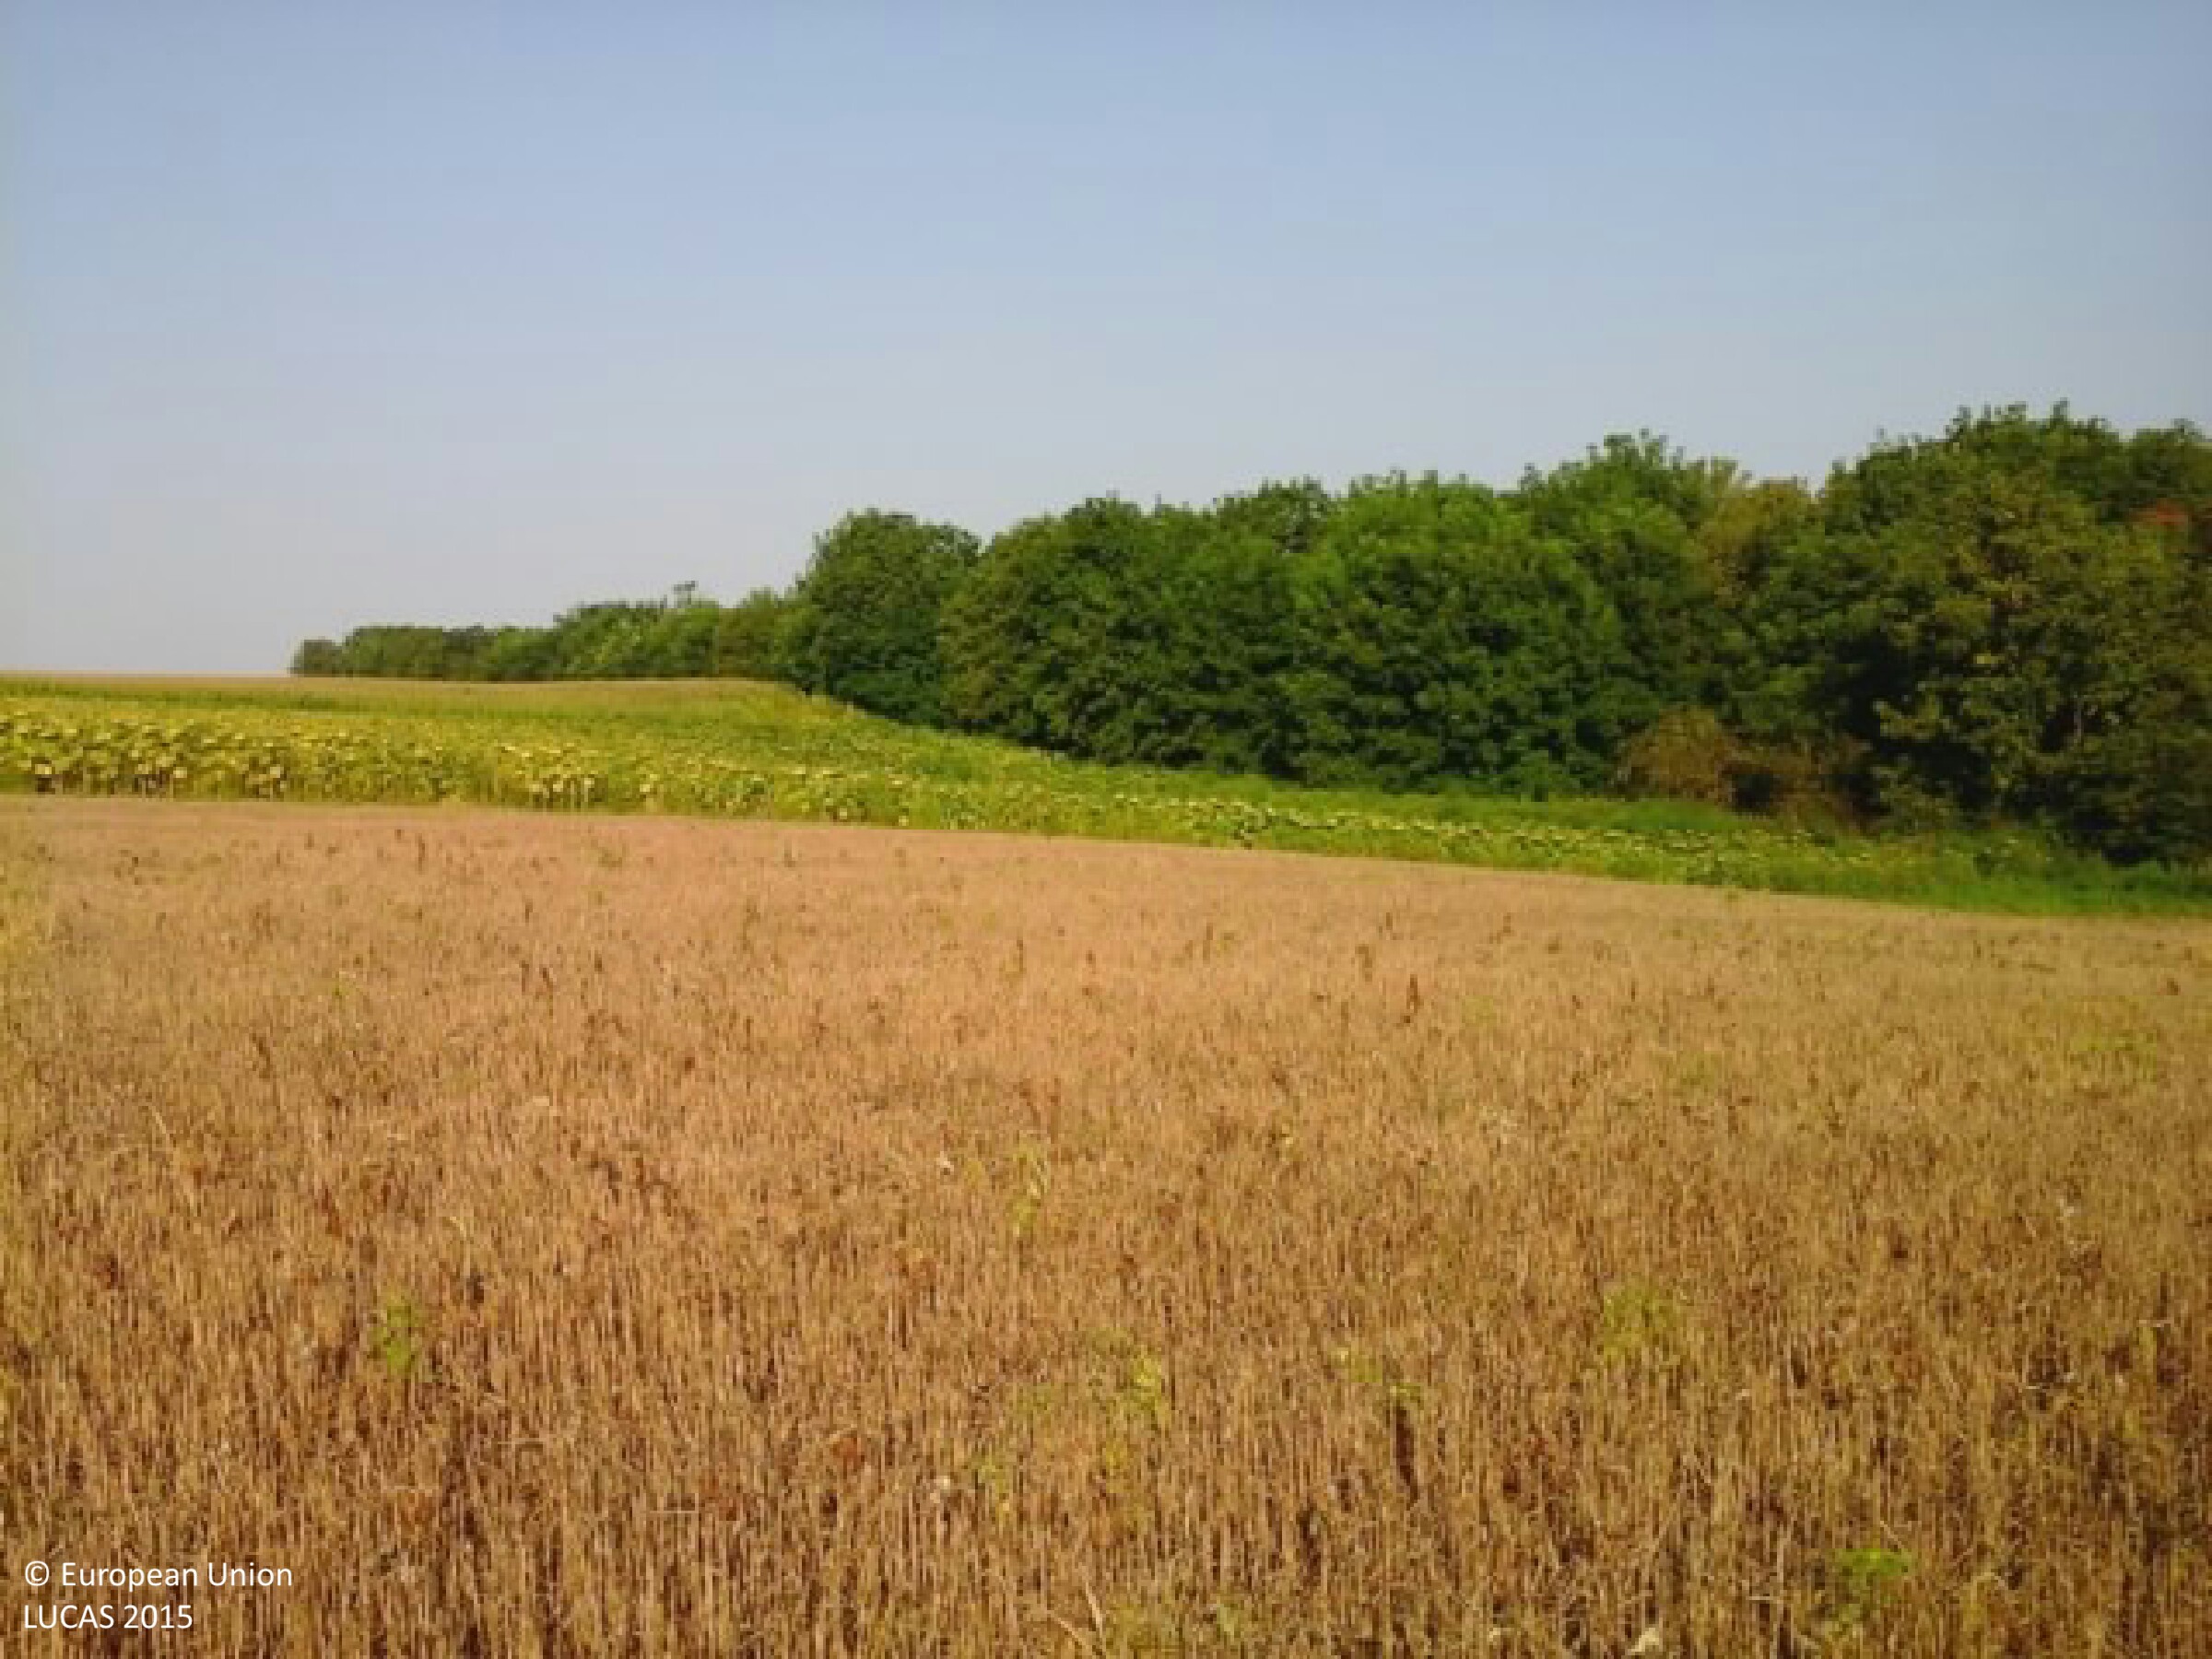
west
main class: Cropland
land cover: Common wheat
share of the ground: > 75 %
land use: Agriculture (excluding fallow land and kitchen gardens)
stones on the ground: < 10 %
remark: Harvested field
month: August
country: HU
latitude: 46.4560
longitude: 17.9098
